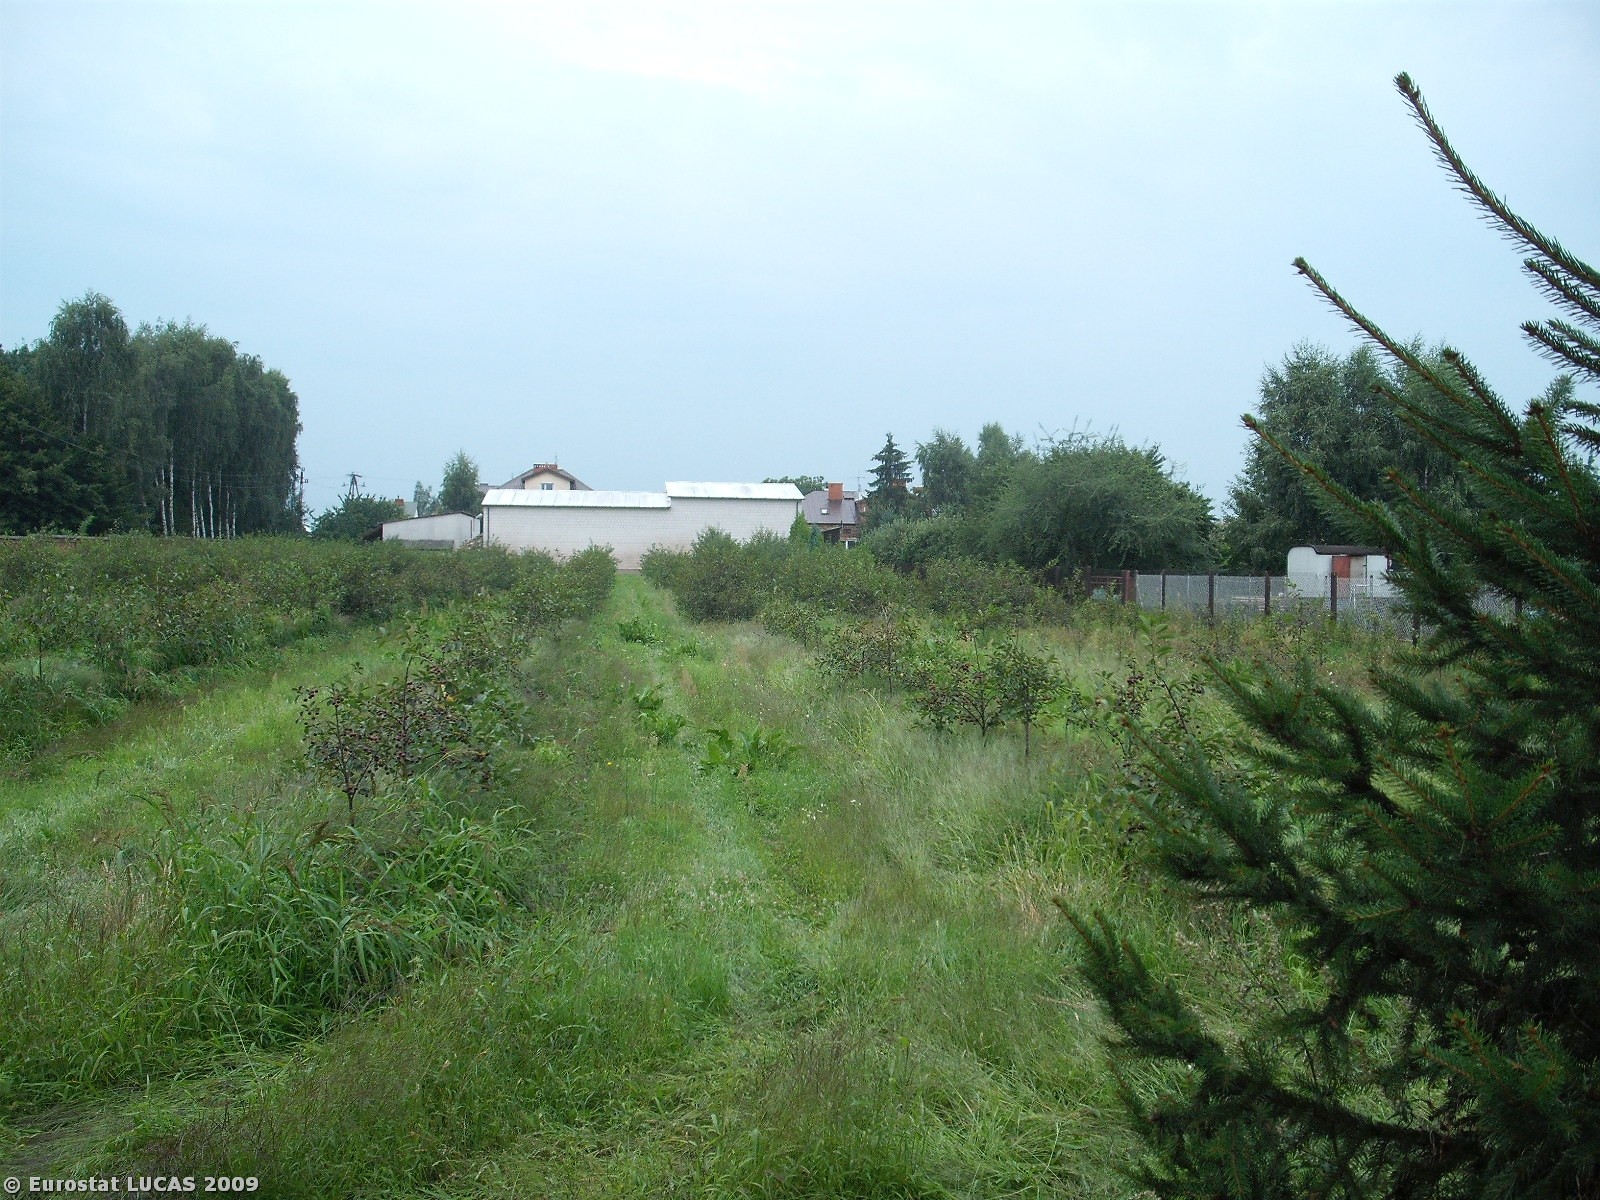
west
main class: Cropland
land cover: Cherry fruit
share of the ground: 25 - 50 %
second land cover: Grassland with sparse tree/shrub cover
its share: > 75 %
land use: Agriculture (excluding fallow land and kitchen gardens)
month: August
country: PL
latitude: 51.9892
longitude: 21.2165
